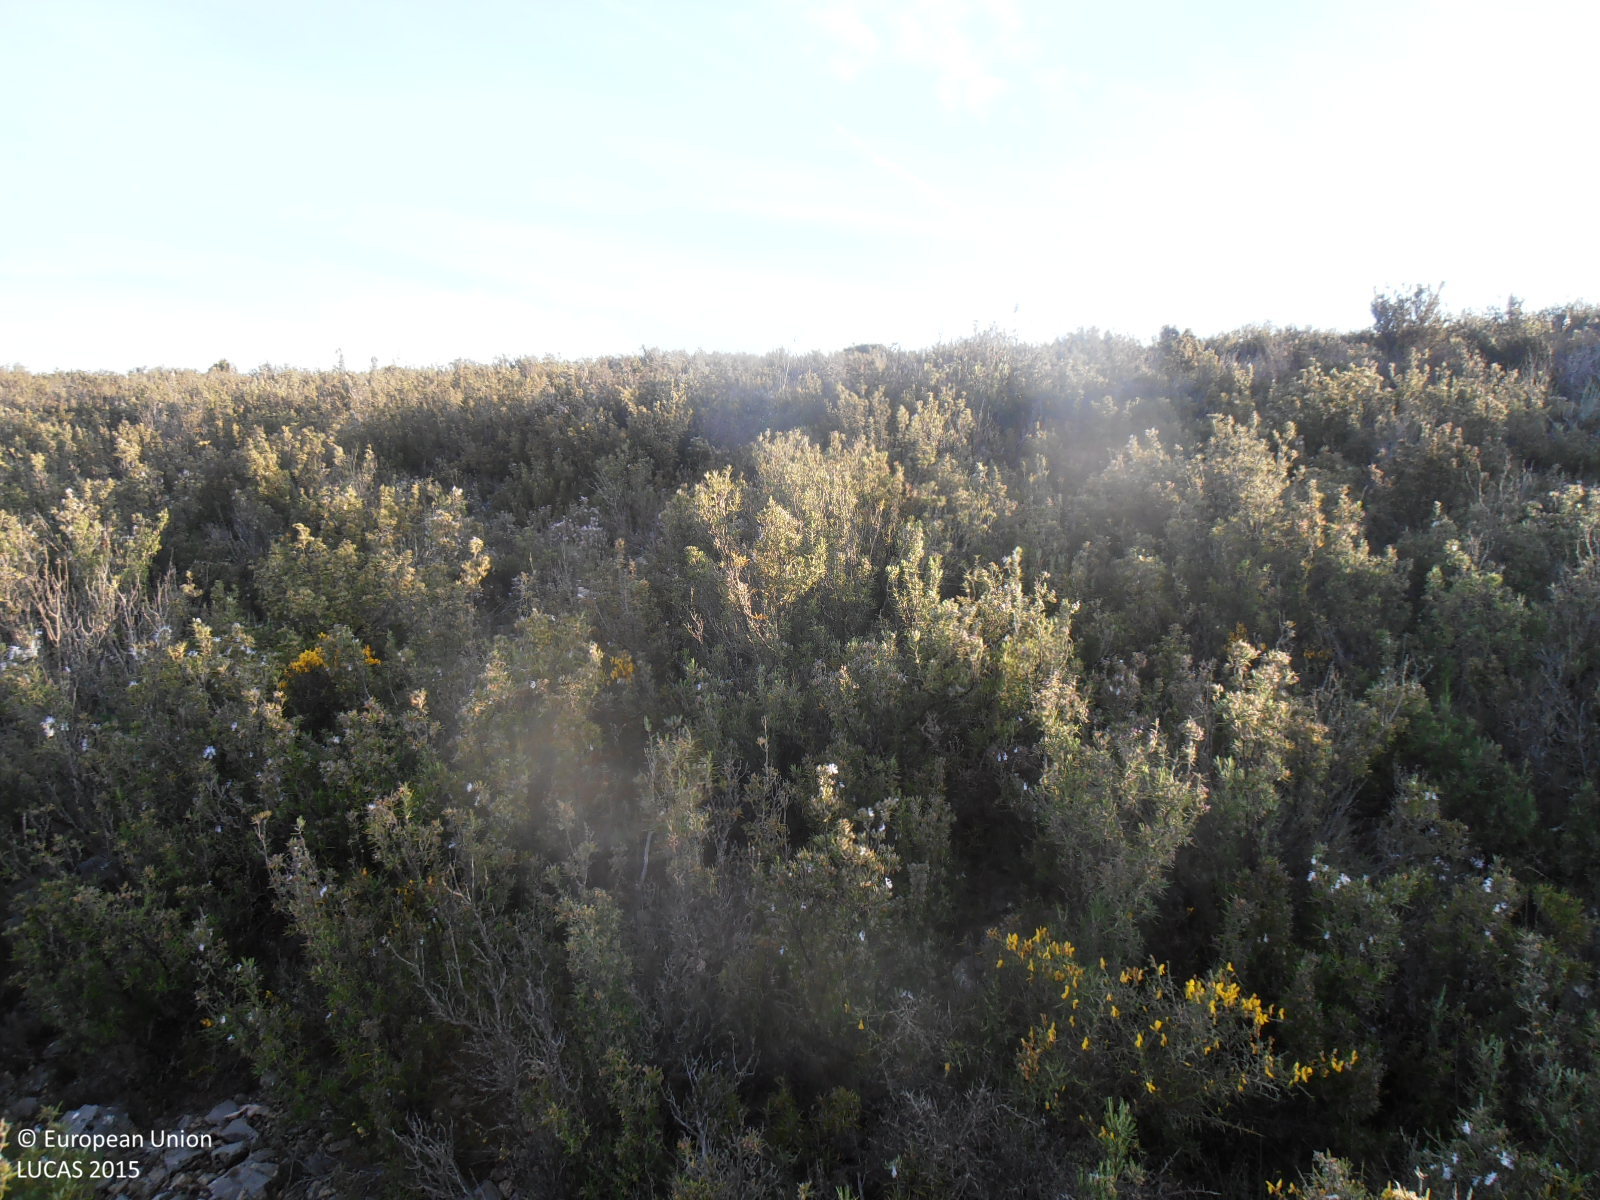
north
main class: Shrubland
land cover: Shrubland without tree cover
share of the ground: > 75 %
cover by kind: shrubs 80 %, herbaceous plants 10 %, consolidated bare surface 10 %
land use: Semi-natural and natural areas not in use
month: April
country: ES
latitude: 41.3807
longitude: -0.9851
